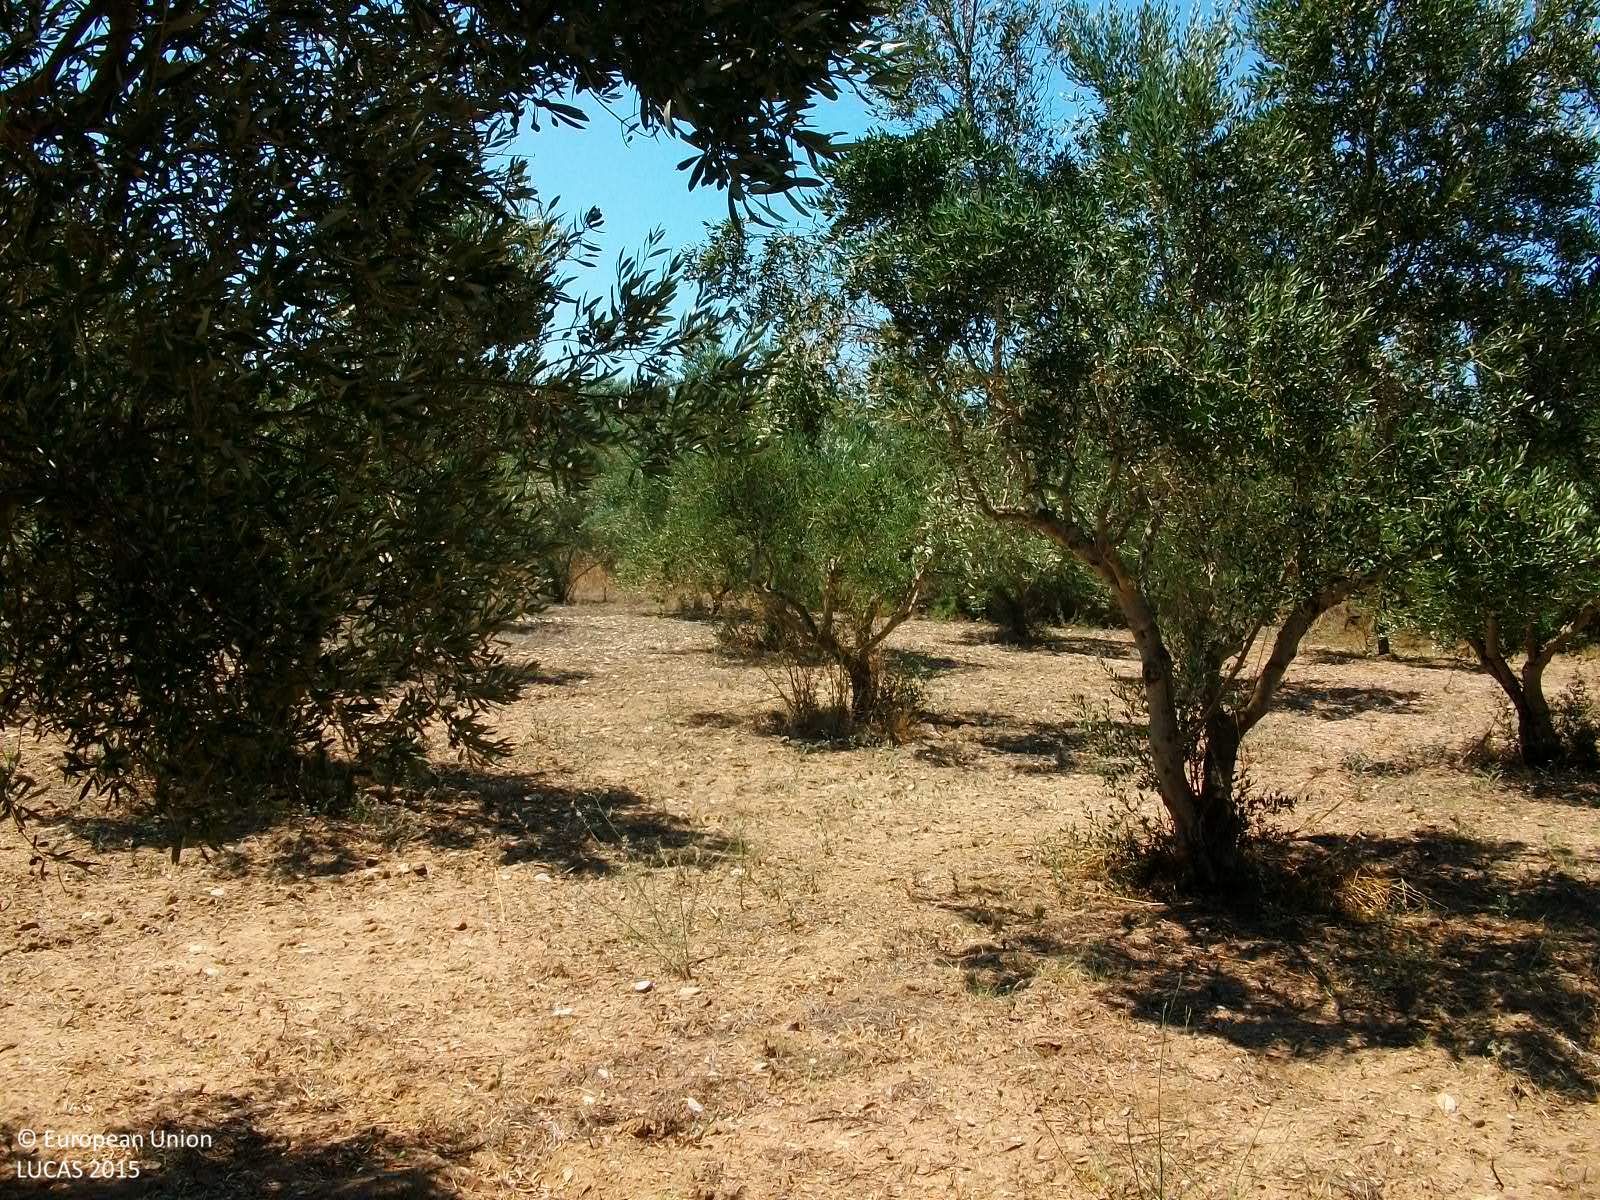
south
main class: Cropland
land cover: Olive groves
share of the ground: 10 - 25 %
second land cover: Spontaneously vegetated surfaces
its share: 10 - 25 %
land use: Agriculture (excluding fallow land and kitchen gardens)
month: July
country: GR
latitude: 36.8488
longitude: 21.9161
